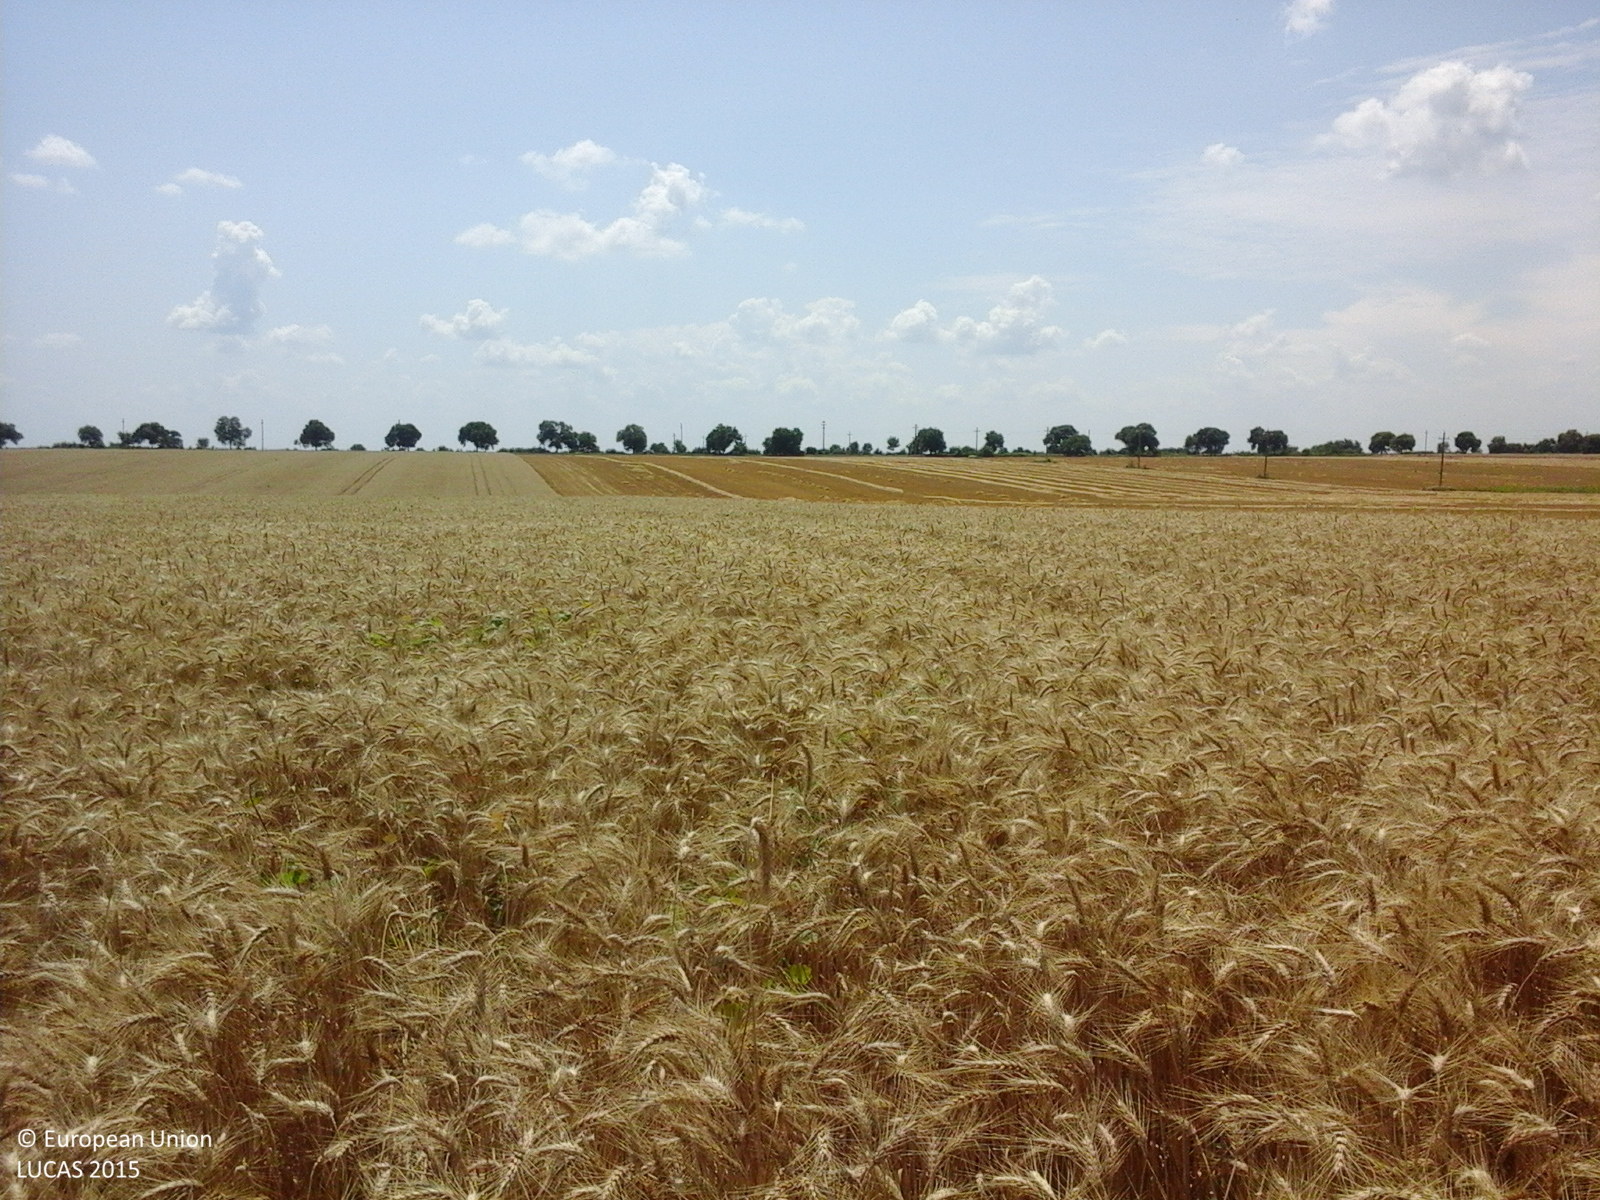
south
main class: Cropland
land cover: Common wheat
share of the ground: > 75 %
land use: Agriculture (excluding fallow land and kitchen gardens)
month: June
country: RO
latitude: 44.1244
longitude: 26.3670
